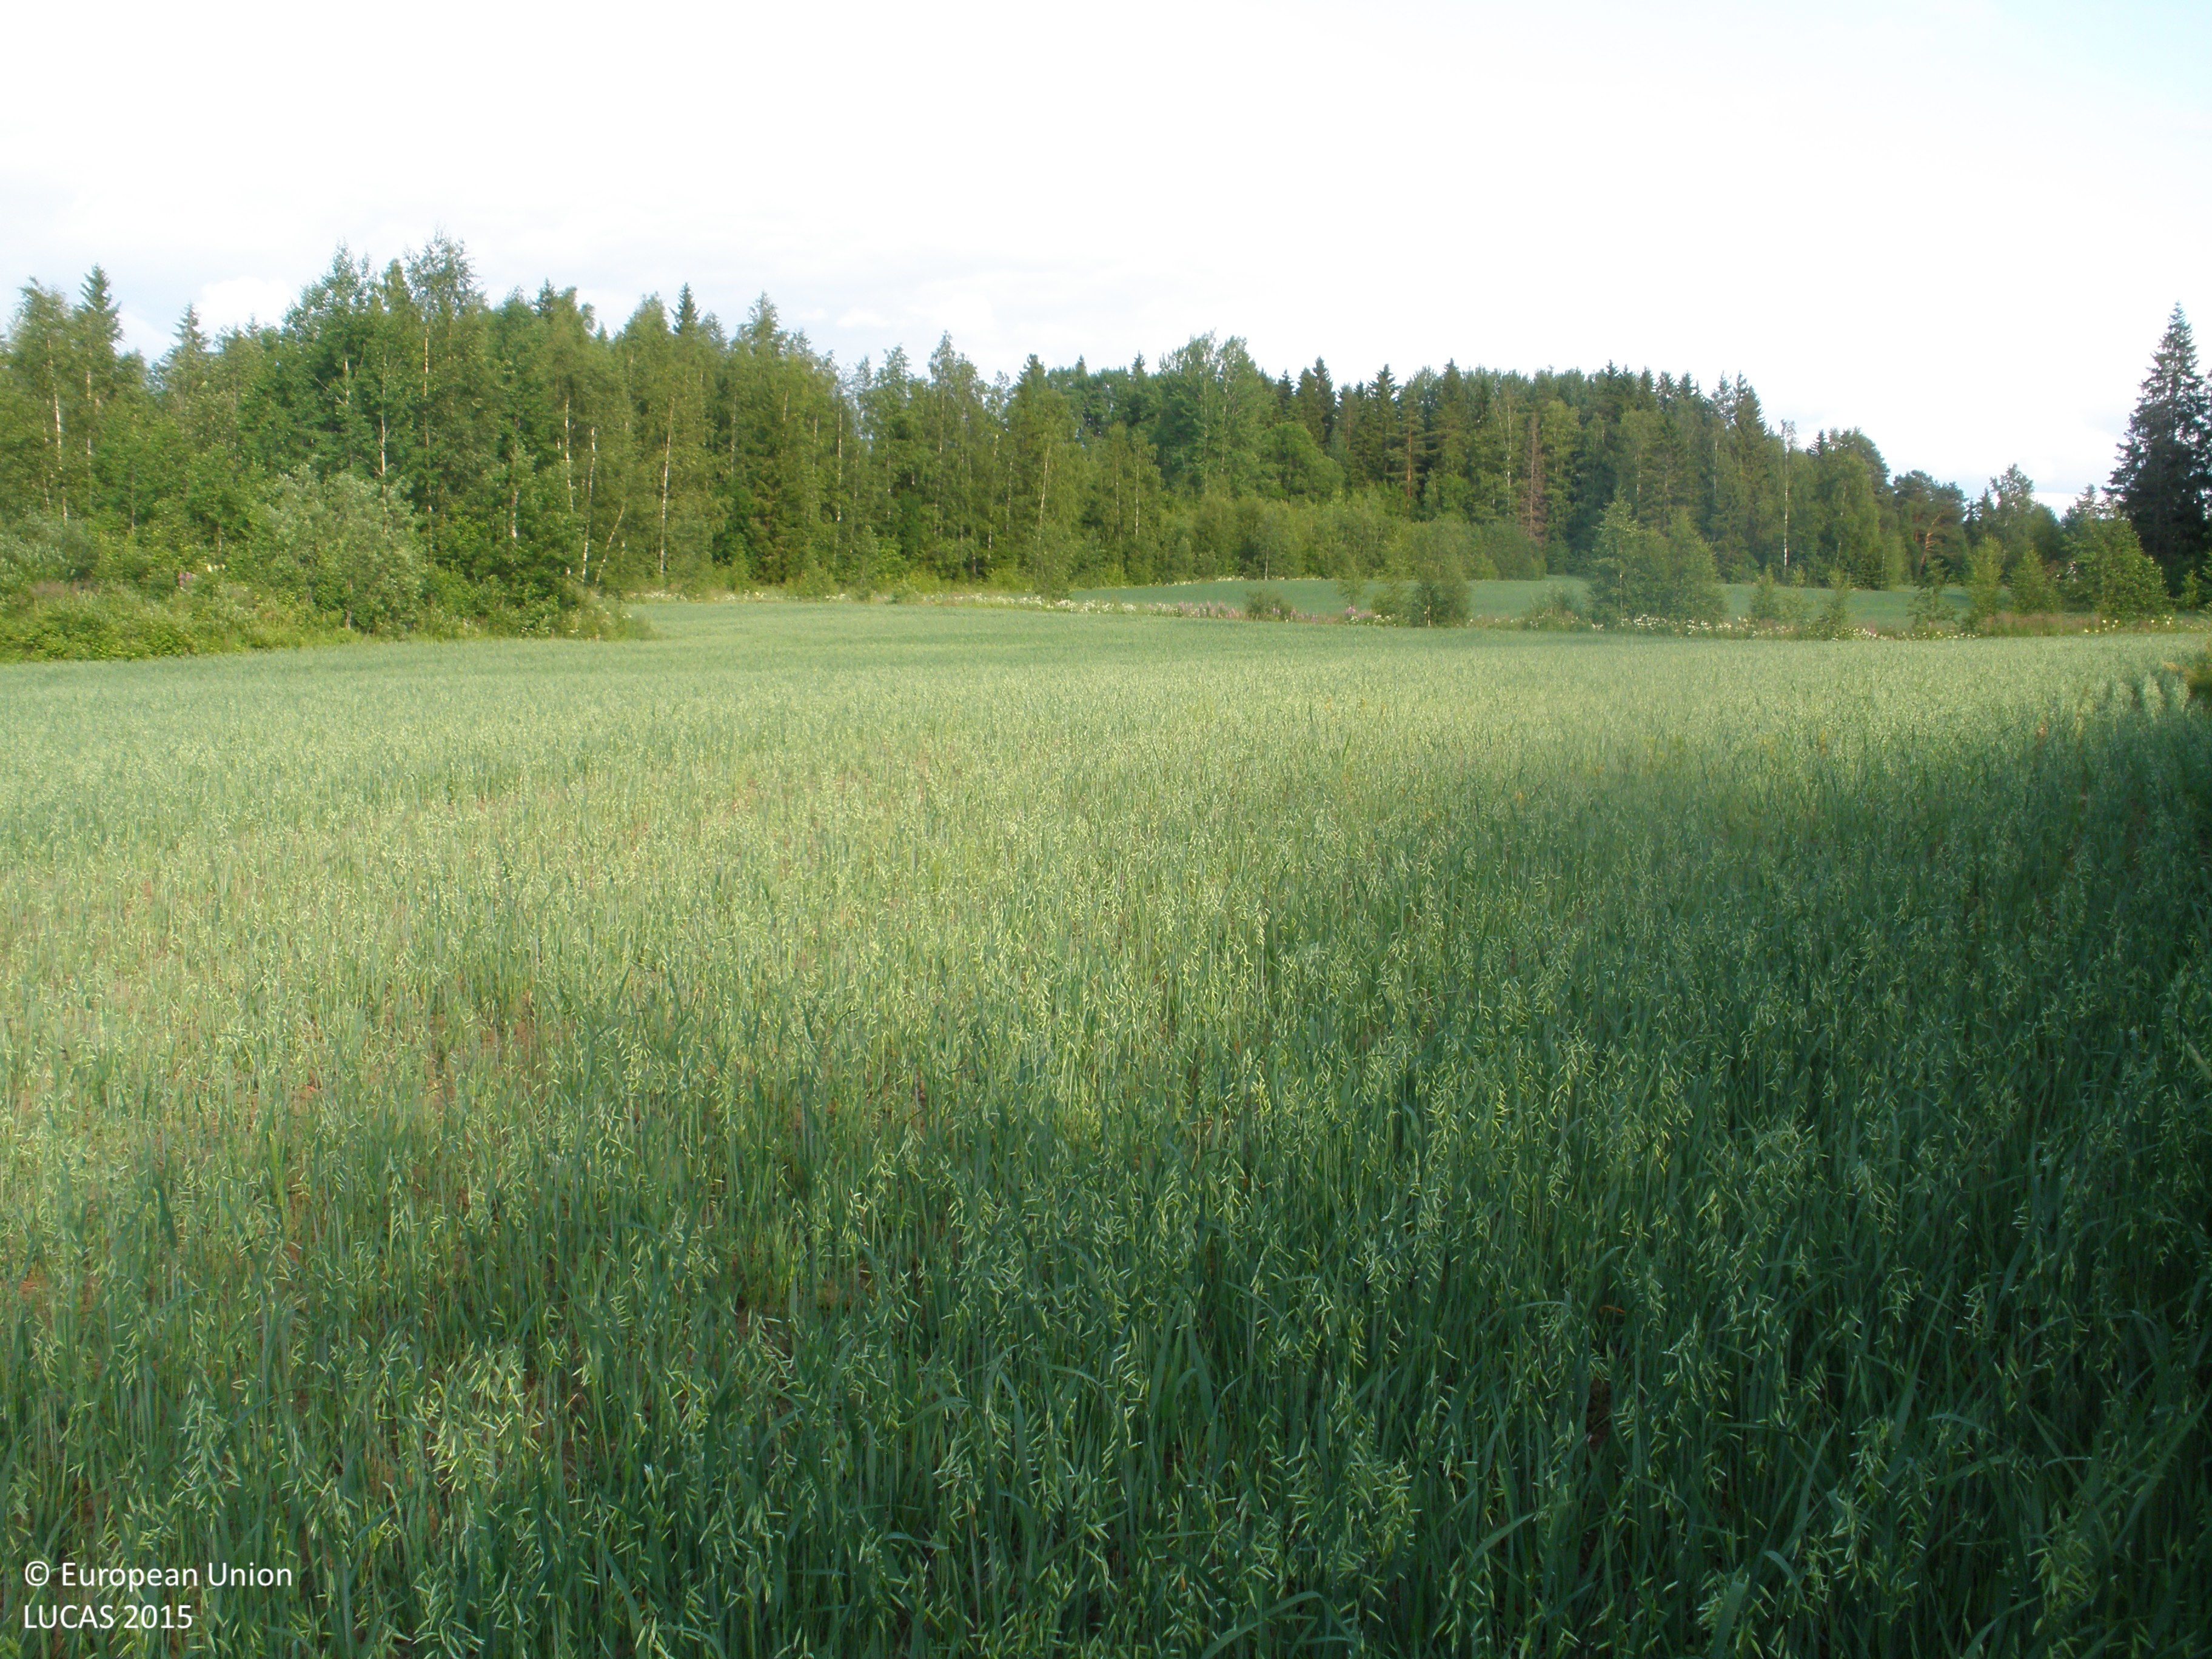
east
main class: Cropland
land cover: Oats
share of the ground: 50 - 75 %
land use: Agriculture (excluding fallow land and kitchen gardens)
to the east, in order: Oats; Electric lines; Oats; Rock outcrops; Oats; Grass margins; Ditches and canals; Broadleaved woodland; Ditches and canals; Spruce dominated mixed woodland; Broadleaved woodland; Shrubland with sparse tree cover; Broadleaved woodland; Ditches and canals; Broadleaved woodland; Spruce dominated mixed woodland
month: July
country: FI
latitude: 61.4238
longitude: 23.9757
